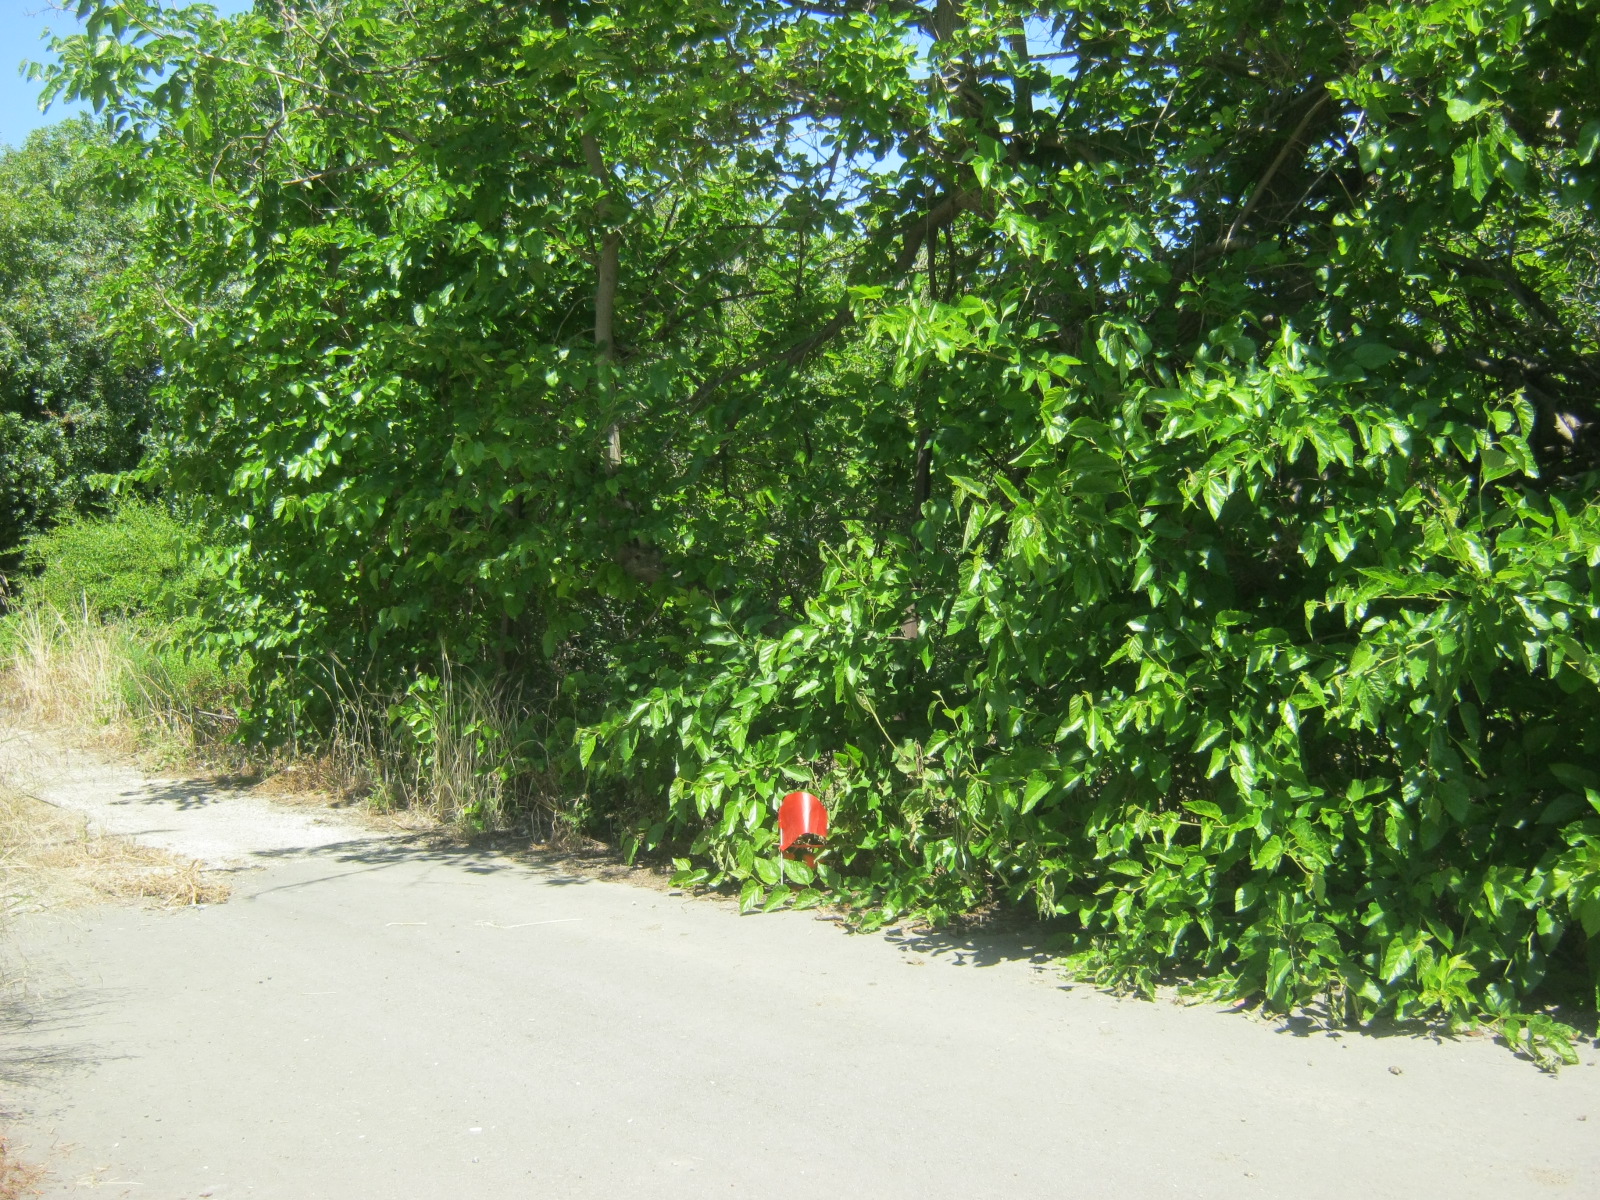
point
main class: Cropland
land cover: Other fruit trees and berries
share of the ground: > 75 %
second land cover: Other bare soil
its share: > 75 %
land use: Agriculture (excluding fallow land and kitchen gardens)
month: May
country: CY
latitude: 35.0852
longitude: 32.8873
